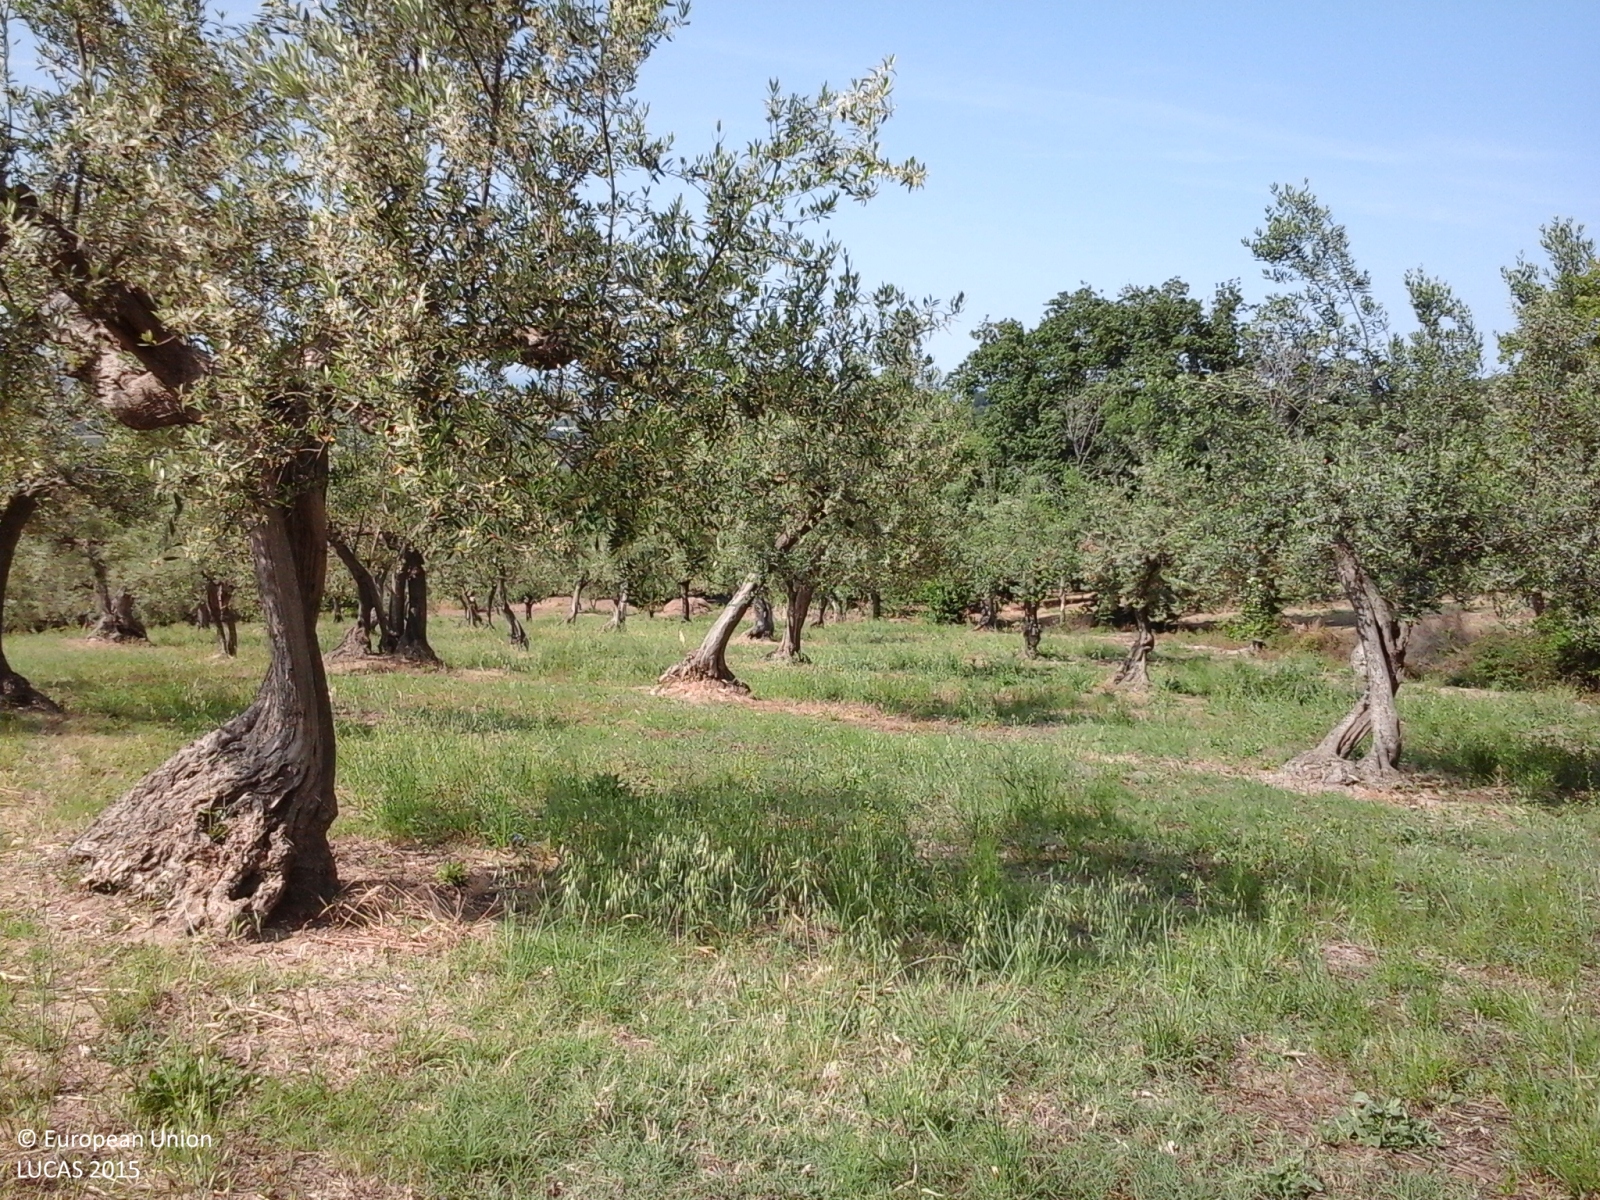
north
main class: Cropland
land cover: Olive groves
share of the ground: 25 - 50 %
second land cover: Spontaneously vegetated surfaces
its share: 25 - 50 %
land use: Agriculture (excluding fallow land and kitchen gardens)
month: May
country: IT
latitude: 42.1741
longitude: 14.5017
